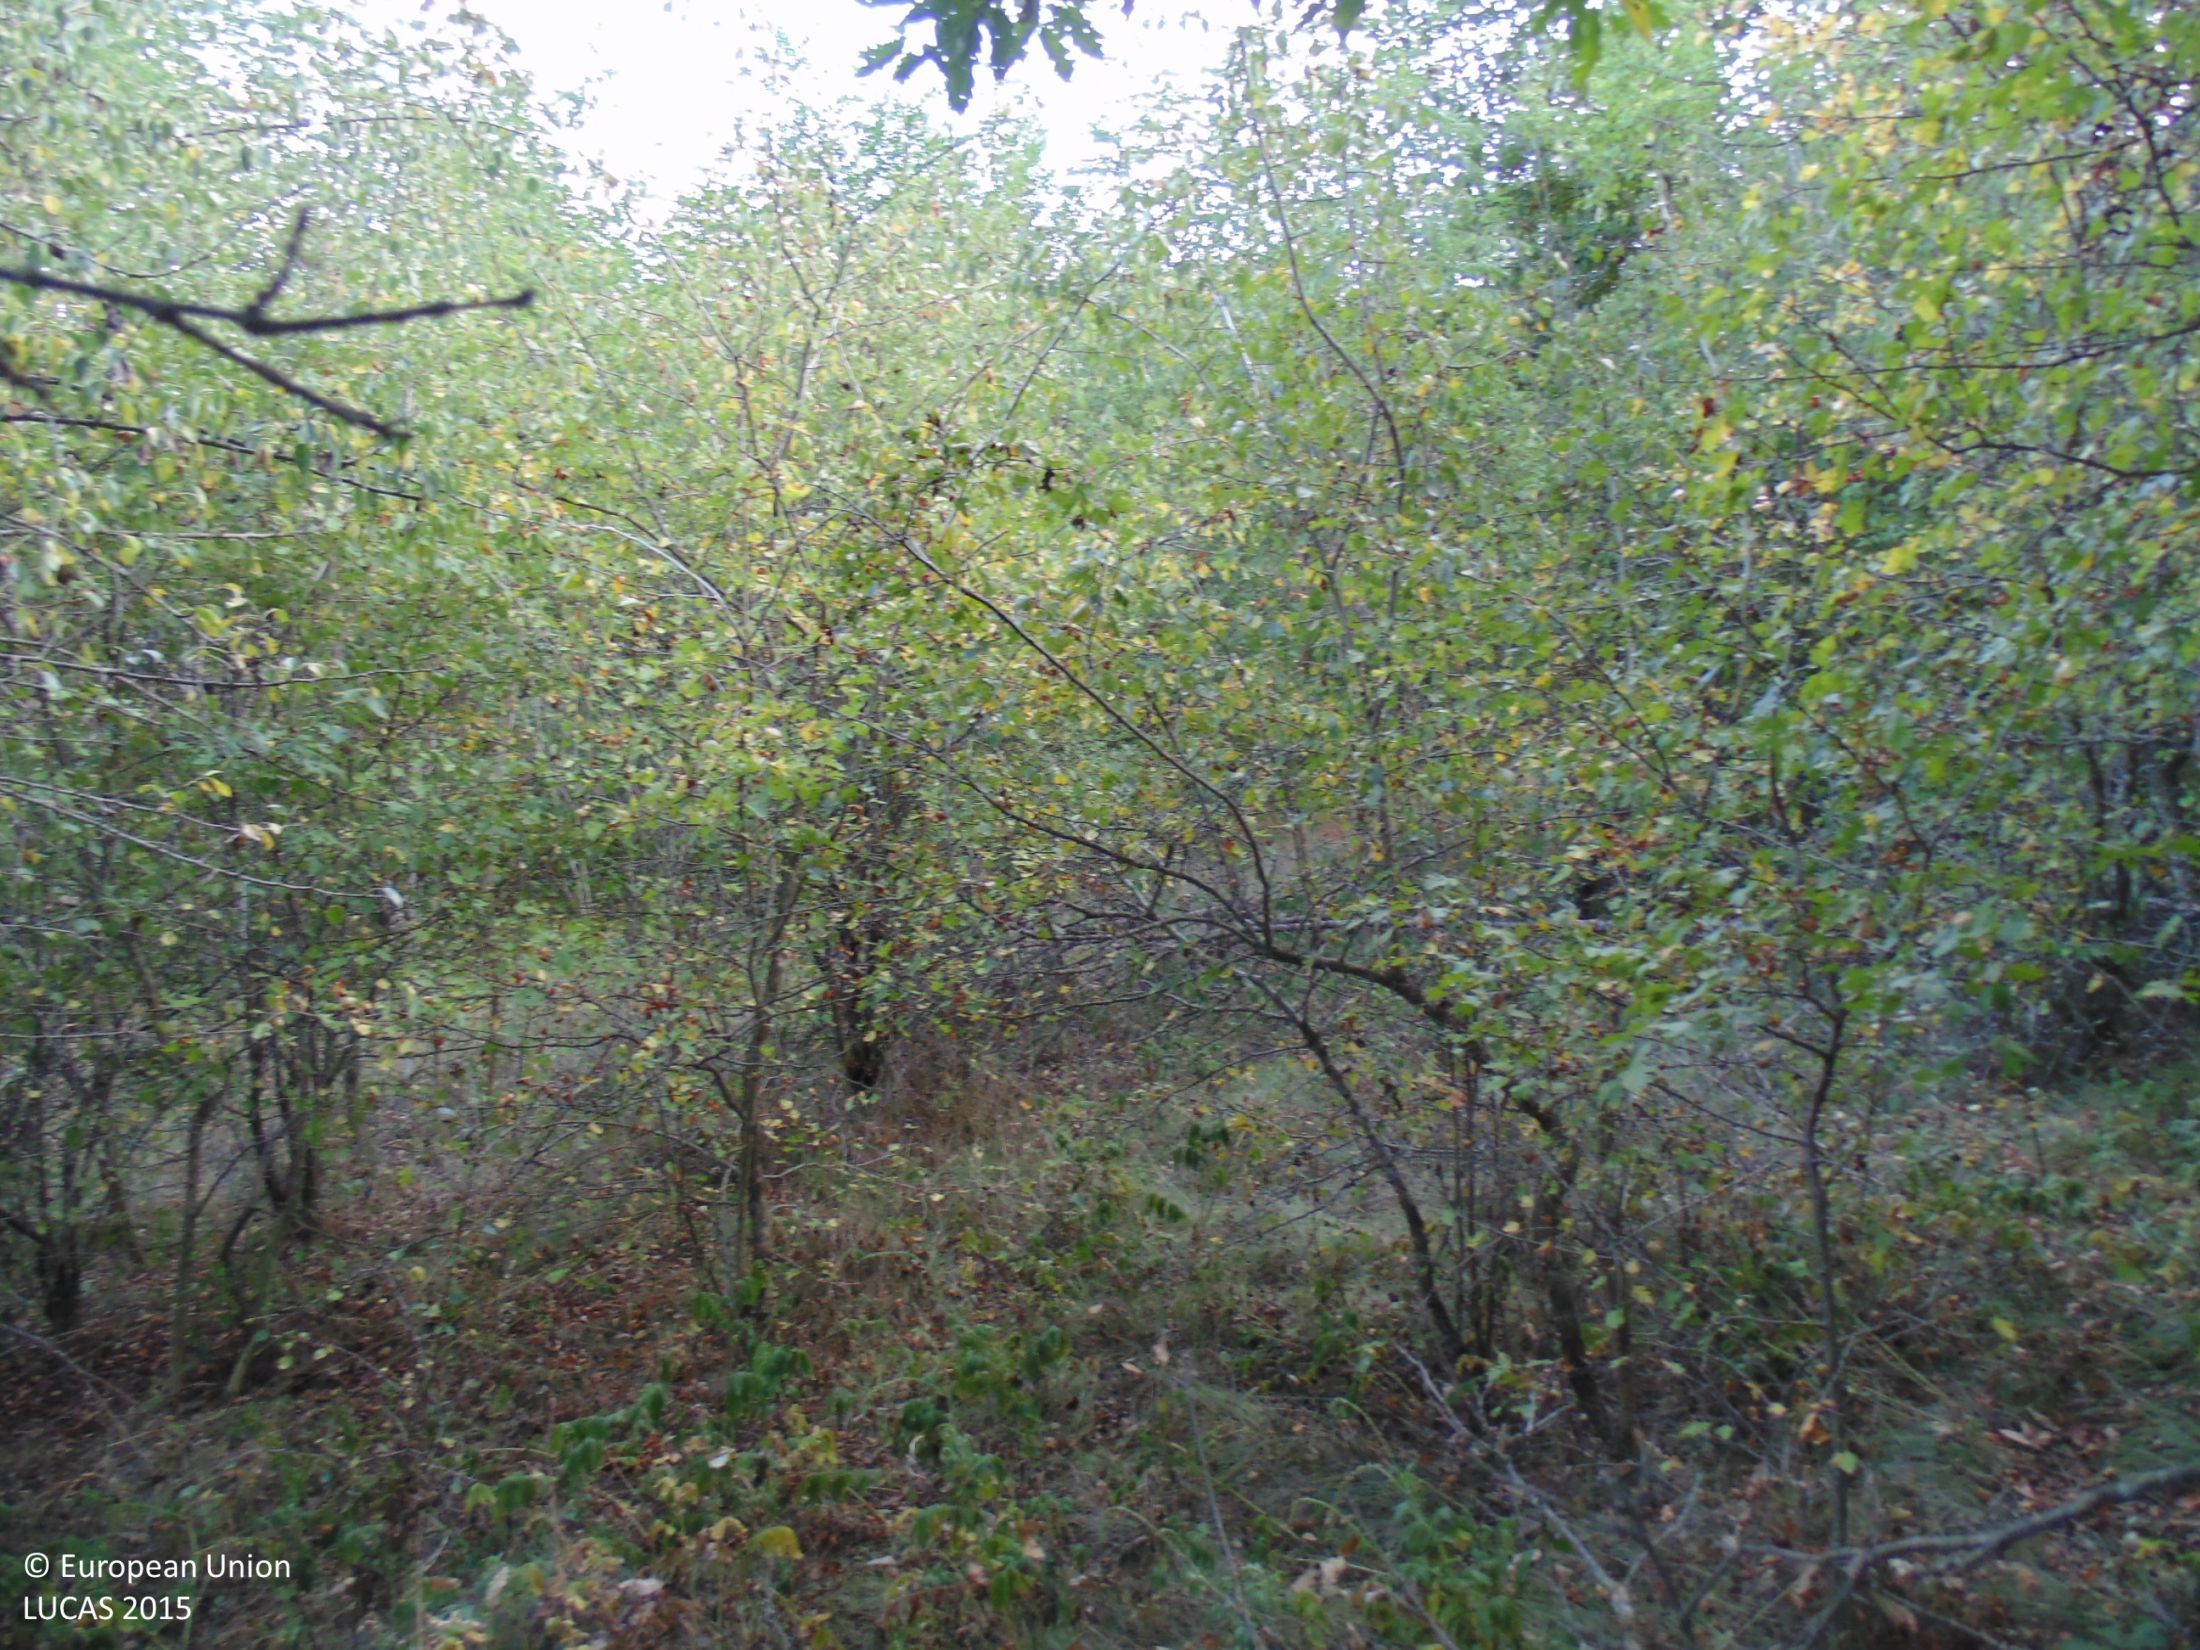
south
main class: Woodland
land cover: Broadleaved woodland
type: mesophytic deciduous forest
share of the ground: > 75 %
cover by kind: broadleaved forest trees 90 %, shrubs 10 %
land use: Forestry
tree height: > 5 m
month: September
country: BG
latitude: 43.8827
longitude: 27.1655
